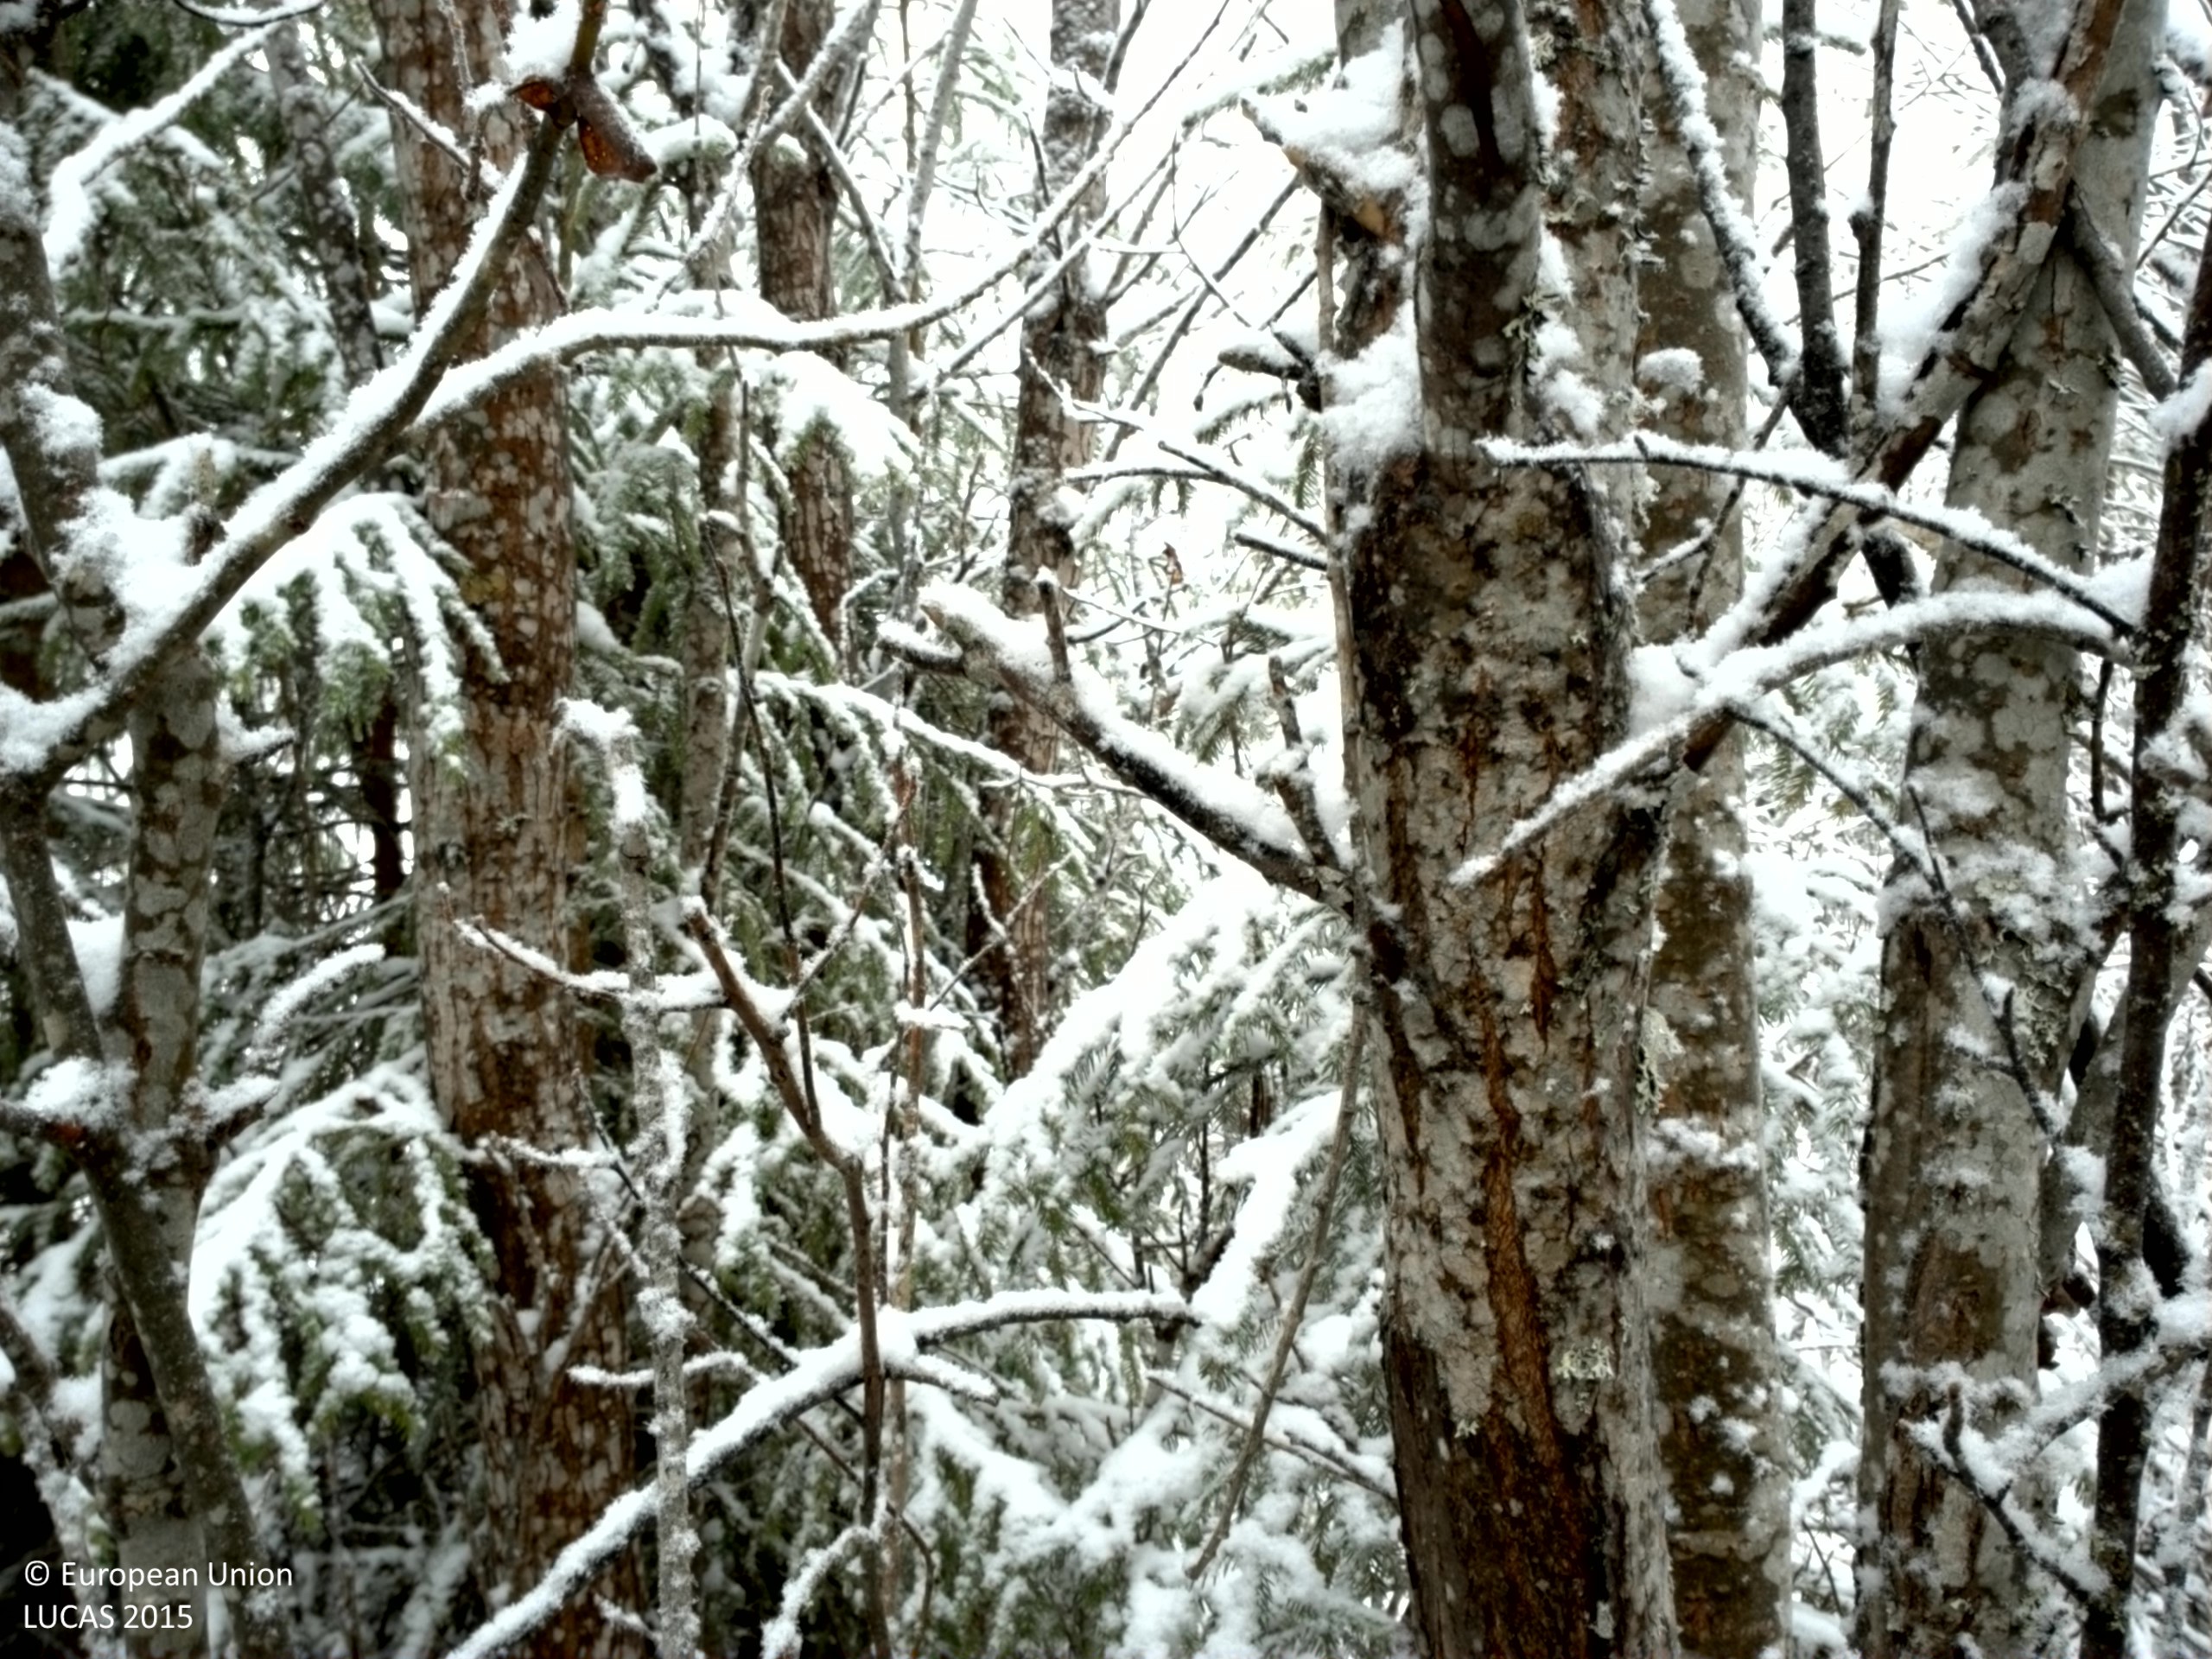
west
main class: Woodland
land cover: Other mixed woodland
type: boreal forest
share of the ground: 50 - 75 %
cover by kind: coniferous forest trees 35 %, broadleaved forest trees 25 %, shrubs 20 %, lichens and mosses 15 %, herbaceous plants 5 %
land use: Forestry
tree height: > 5 m
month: November
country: SE
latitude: 63.6739
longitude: 15.3709
